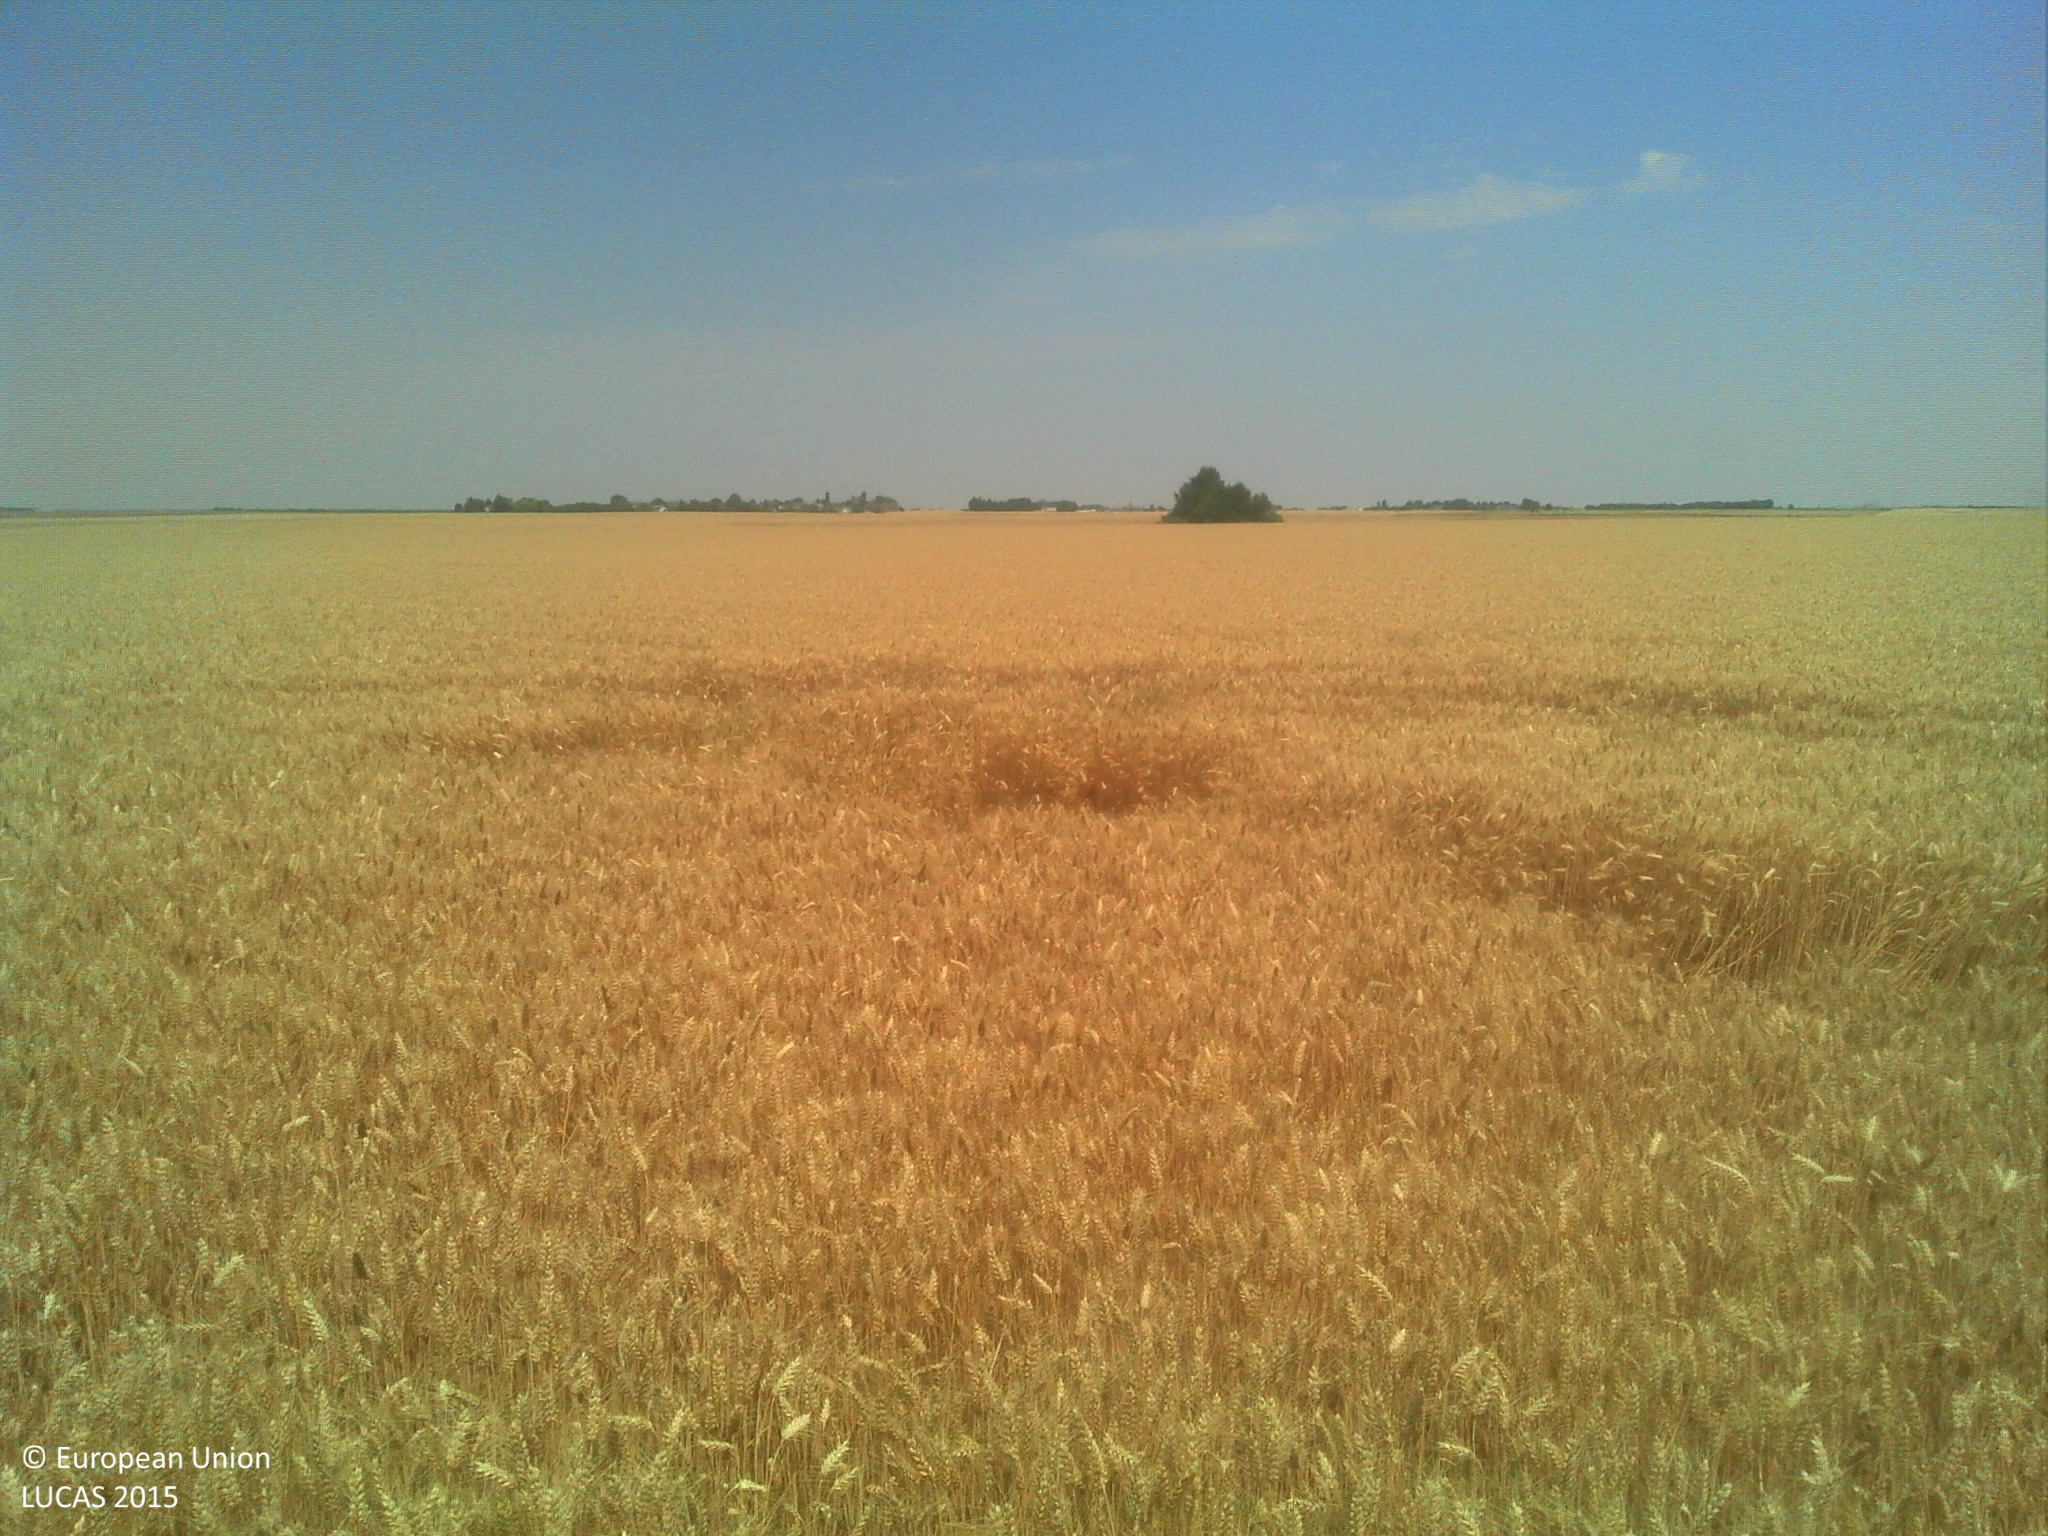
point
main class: Cropland
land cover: Durum wheat
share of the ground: > 75 %
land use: Agriculture (excluding fallow land and kitchen gardens)
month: July
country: FR
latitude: 47.6873
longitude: 1.3917
